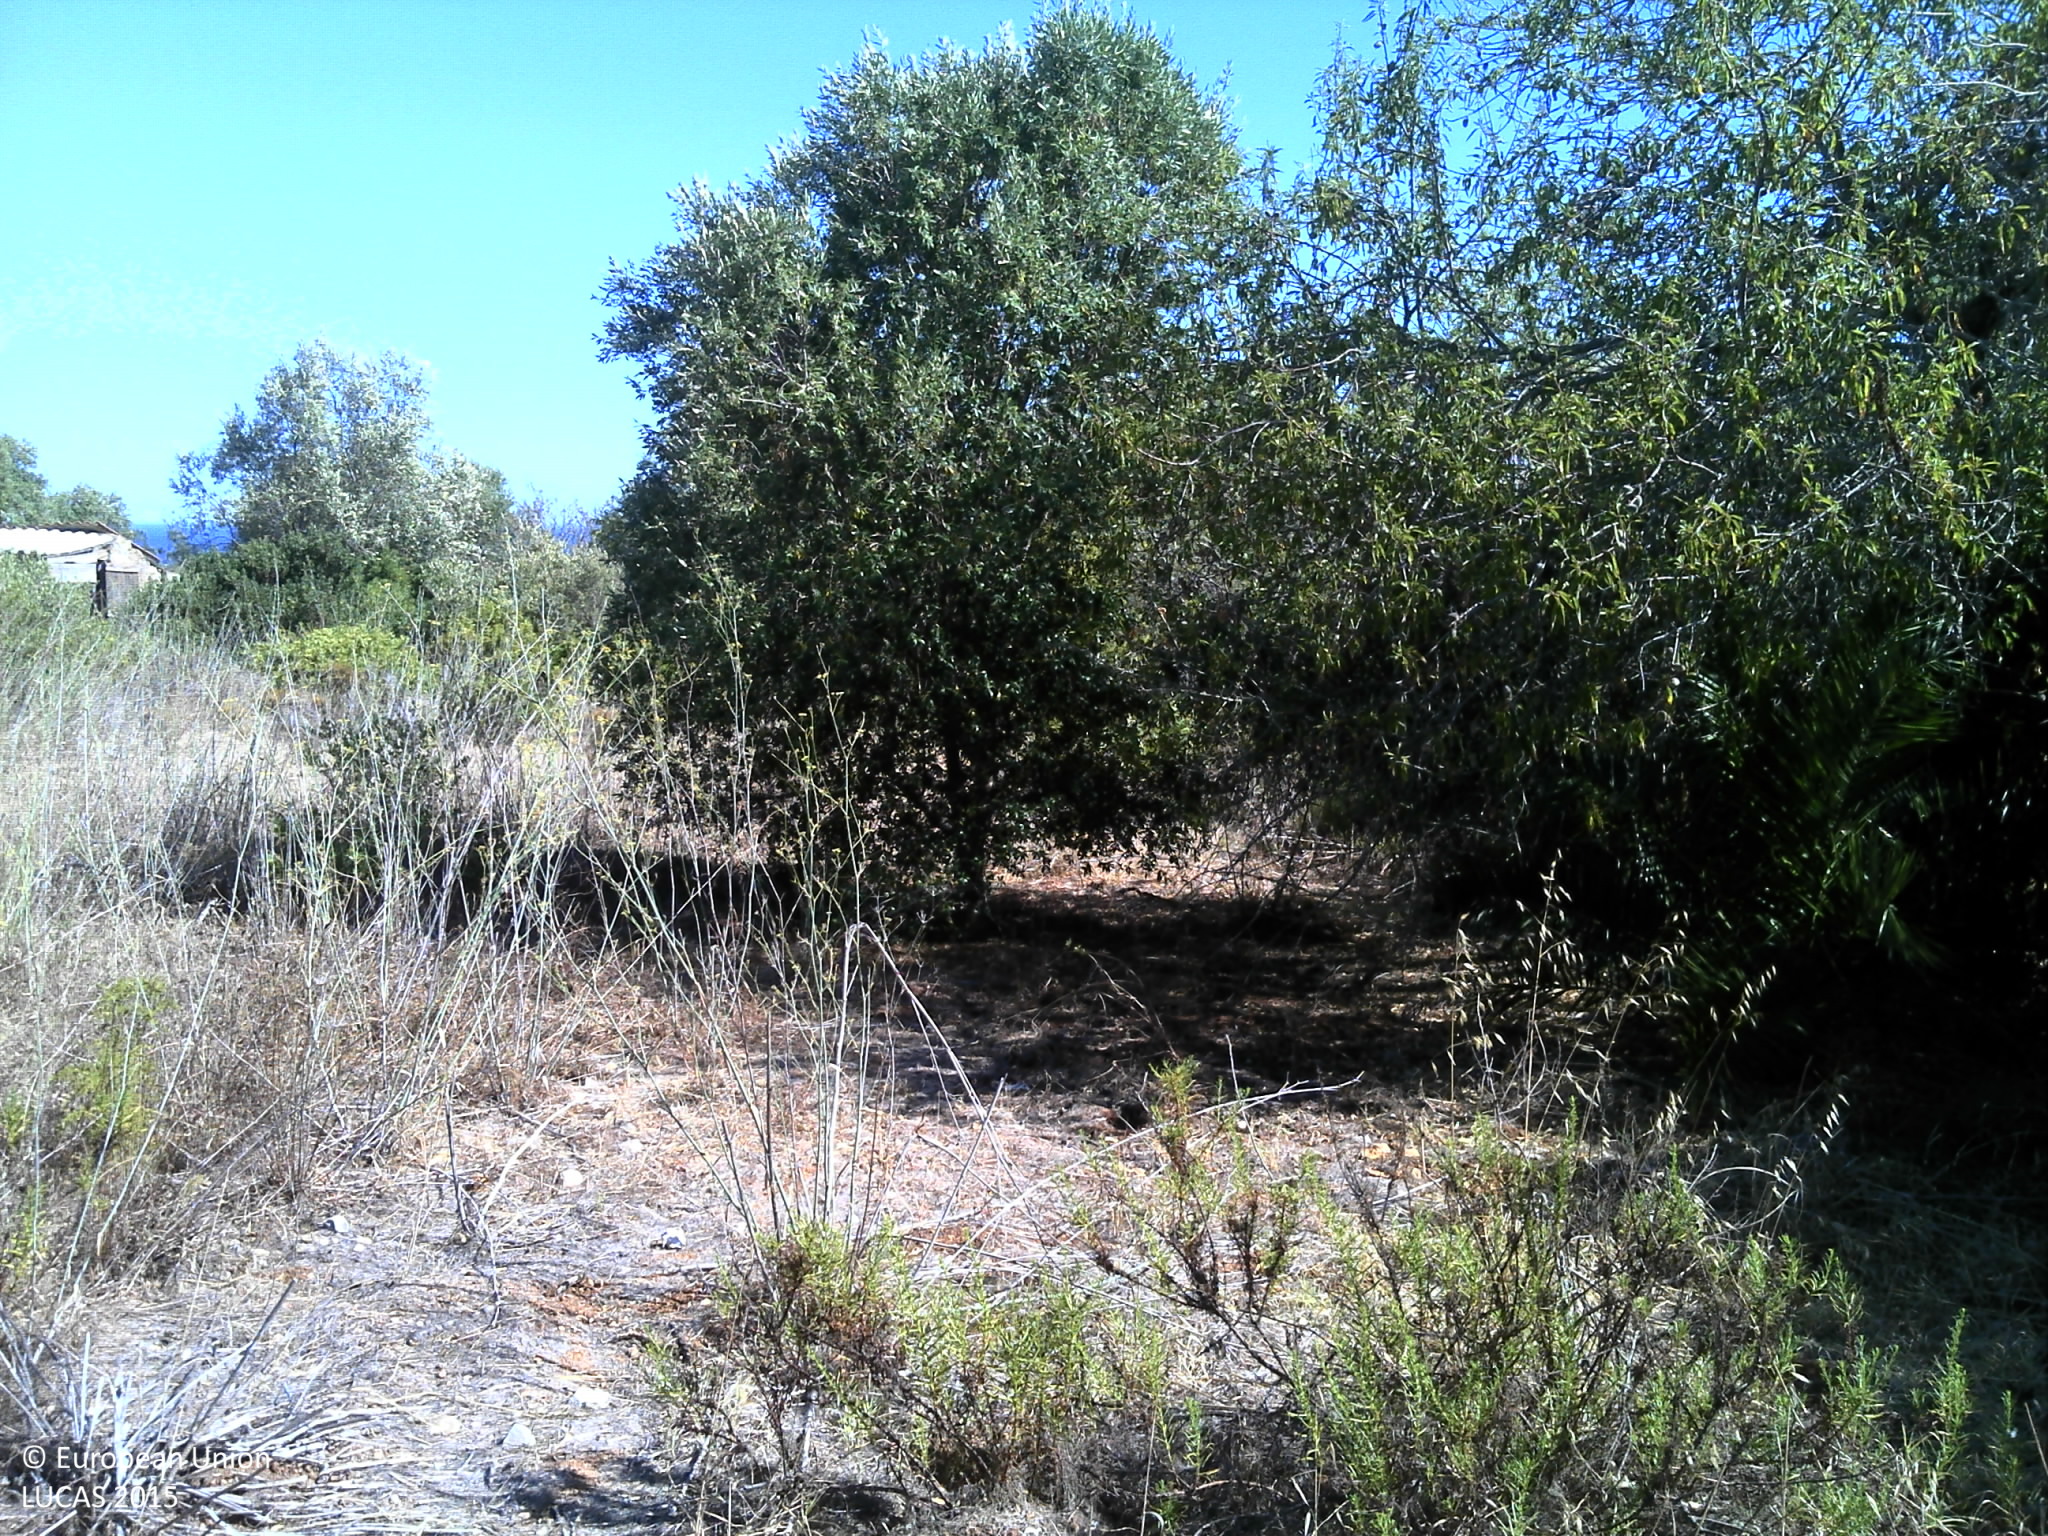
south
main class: Cropland
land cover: Nuts trees
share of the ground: 25 - 50 %
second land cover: Grassland without tree/shrub cover
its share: 25 - 50 %
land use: Agriculture (excluding fallow land and kitchen gardens)
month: July
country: PT
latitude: 37.0908
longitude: -8.7388
